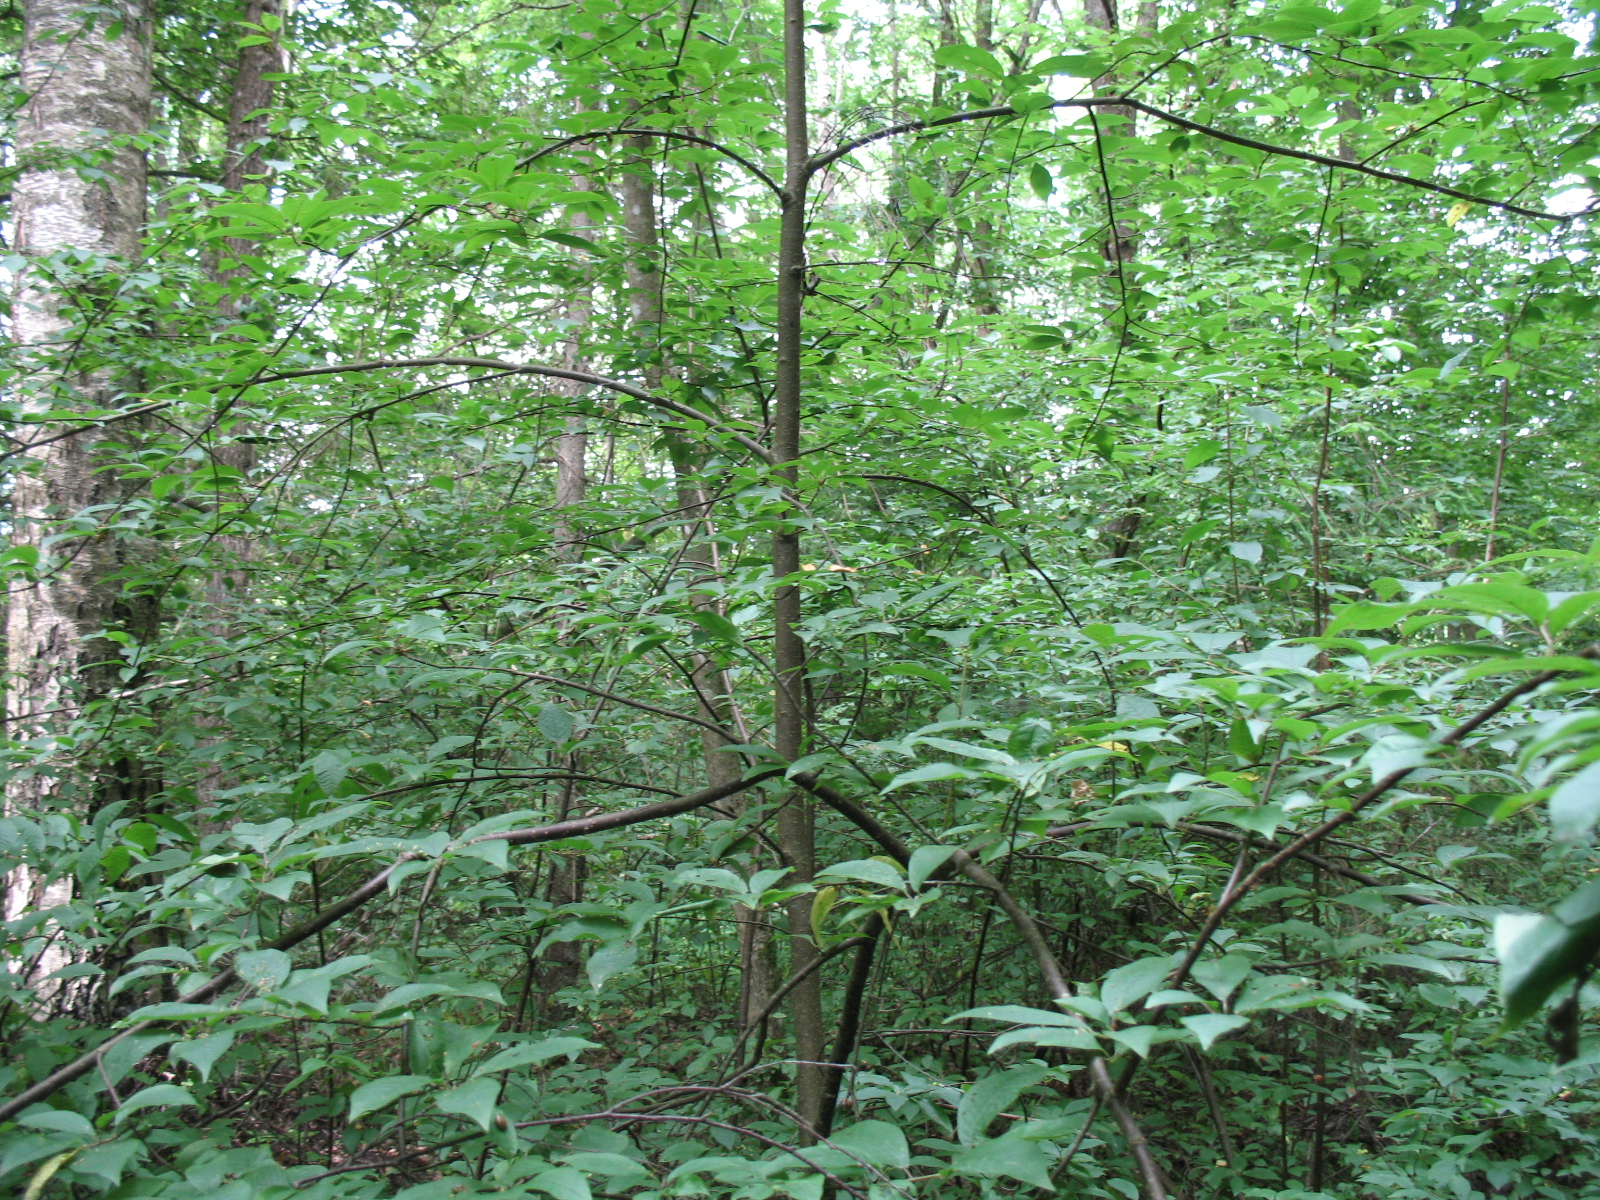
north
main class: Woodland
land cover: Broadleaved woodland
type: non-riverine alder, birch or aspen forest
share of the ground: > 75 %
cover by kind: broadleaved forest trees 80 %, coniferous forest trees 10 %, herbaceous plants 10 %
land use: Forestry
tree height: > 5 m
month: June
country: LV
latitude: 56.7002
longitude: 23.7819
